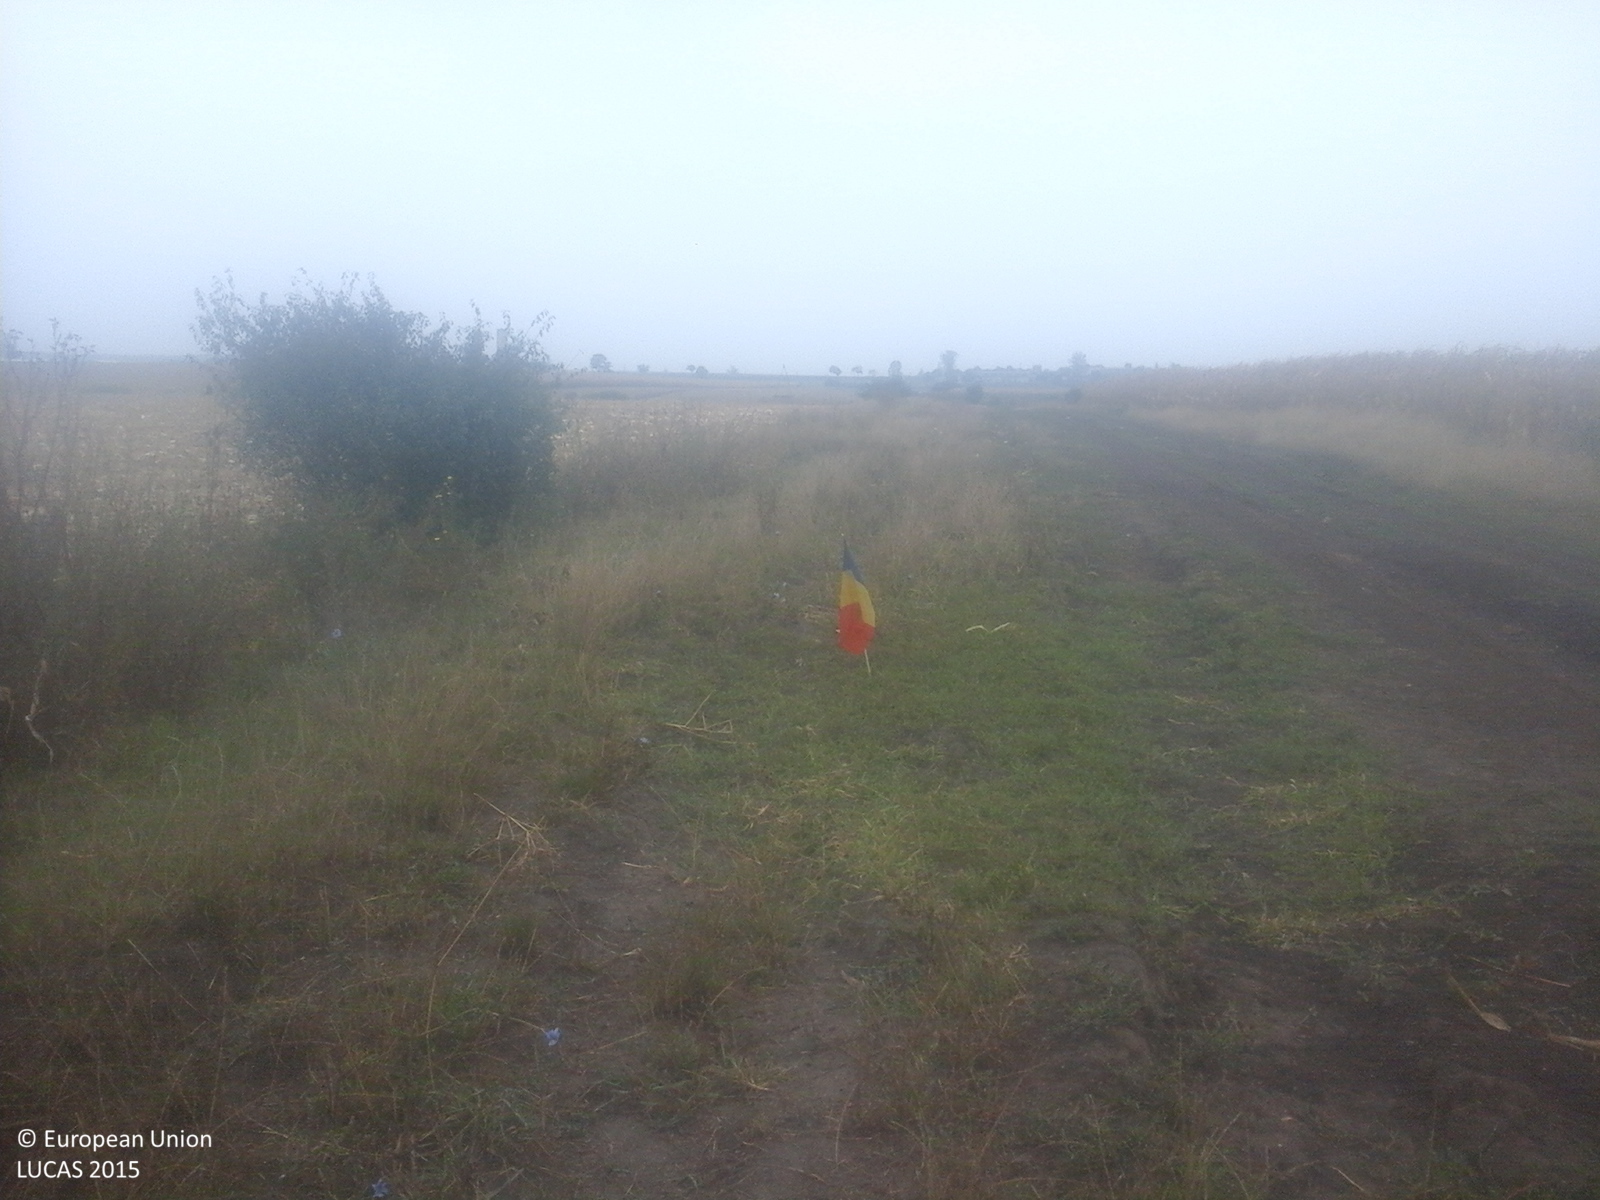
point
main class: Grassland
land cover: Grassland without tree/shrub cover
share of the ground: > 75 %
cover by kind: herbaceous plants 100 %
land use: Agriculture (excluding fallow land and kitchen gardens)
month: September
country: RO
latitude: 47.5003
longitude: 22.4150
